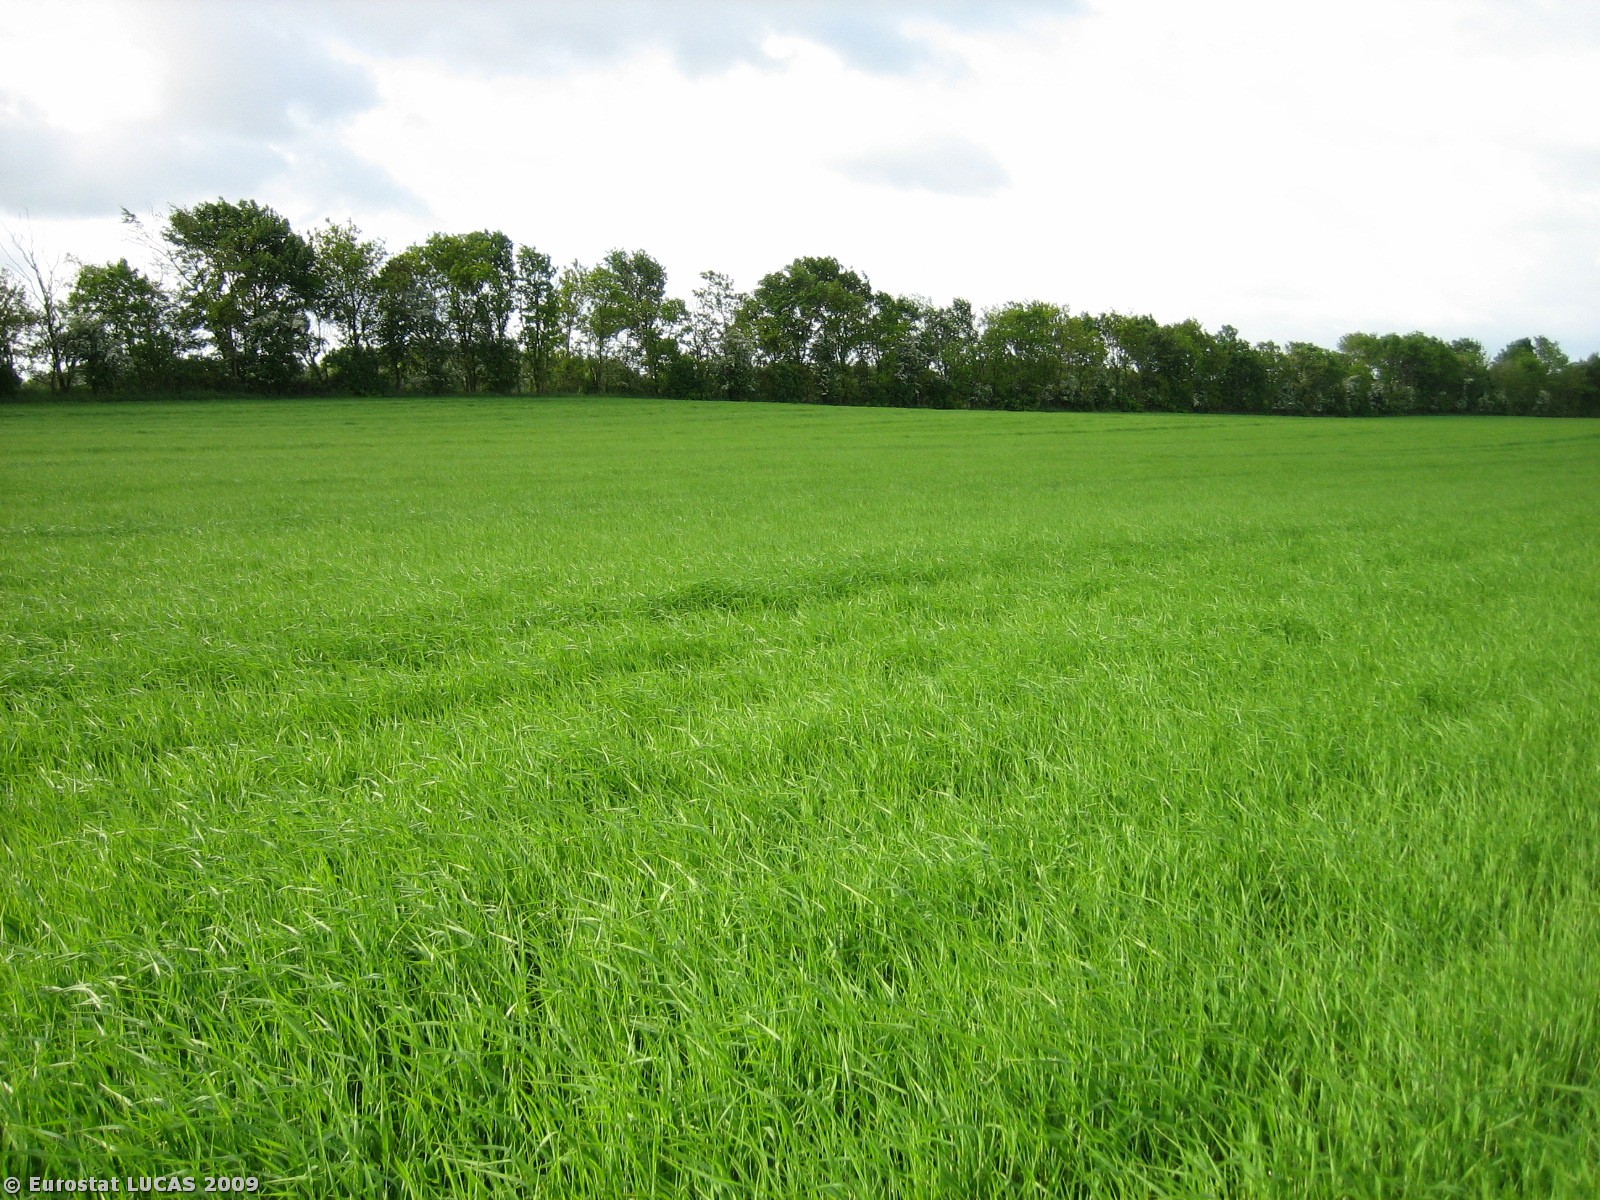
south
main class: Cropland
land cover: Barley
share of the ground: > 75 %
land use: Agriculture (excluding fallow land and kitchen gardens)
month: May
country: DK
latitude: 55.8977
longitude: 9.2172
